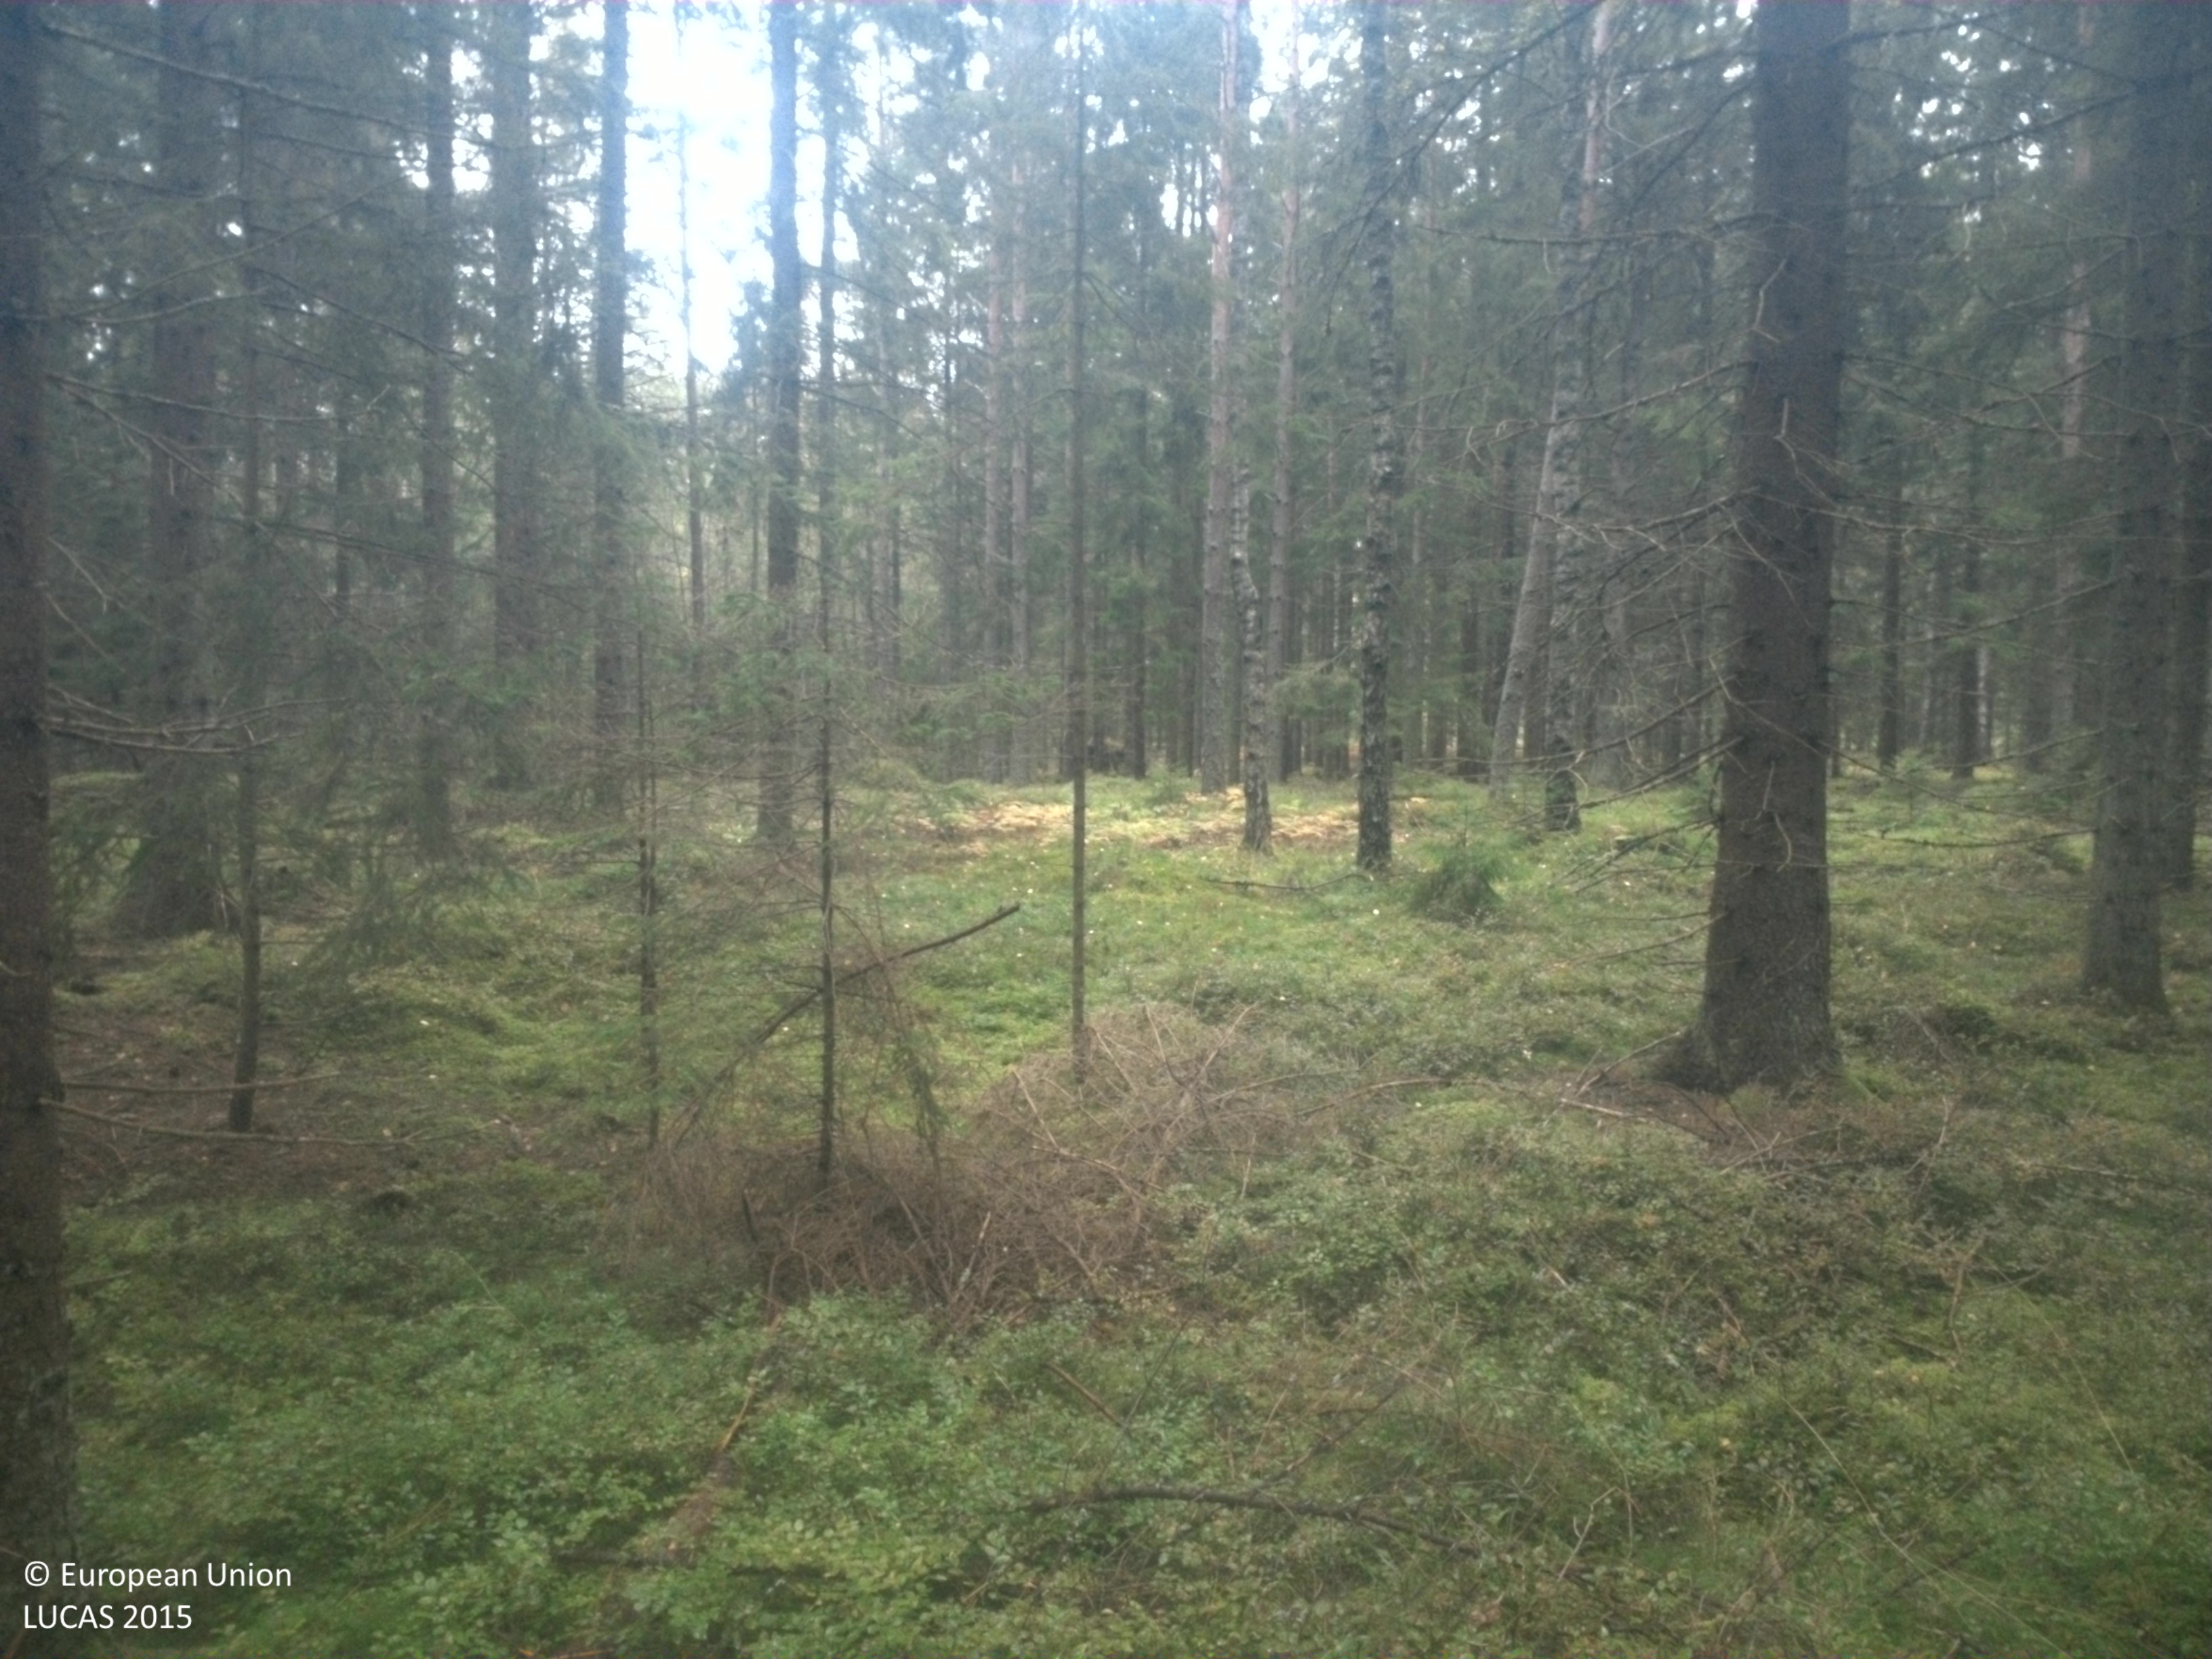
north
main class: Woodland
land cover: Spruce dominated coniferous woodland
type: boreal forest
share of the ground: 50 - 75 %
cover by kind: coniferous forest trees 60 %, lichens and mosses 25 %, shrubs 15 %
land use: Forestry
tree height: > 5 m
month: September
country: SE
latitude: 58.7718
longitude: 14.0223
